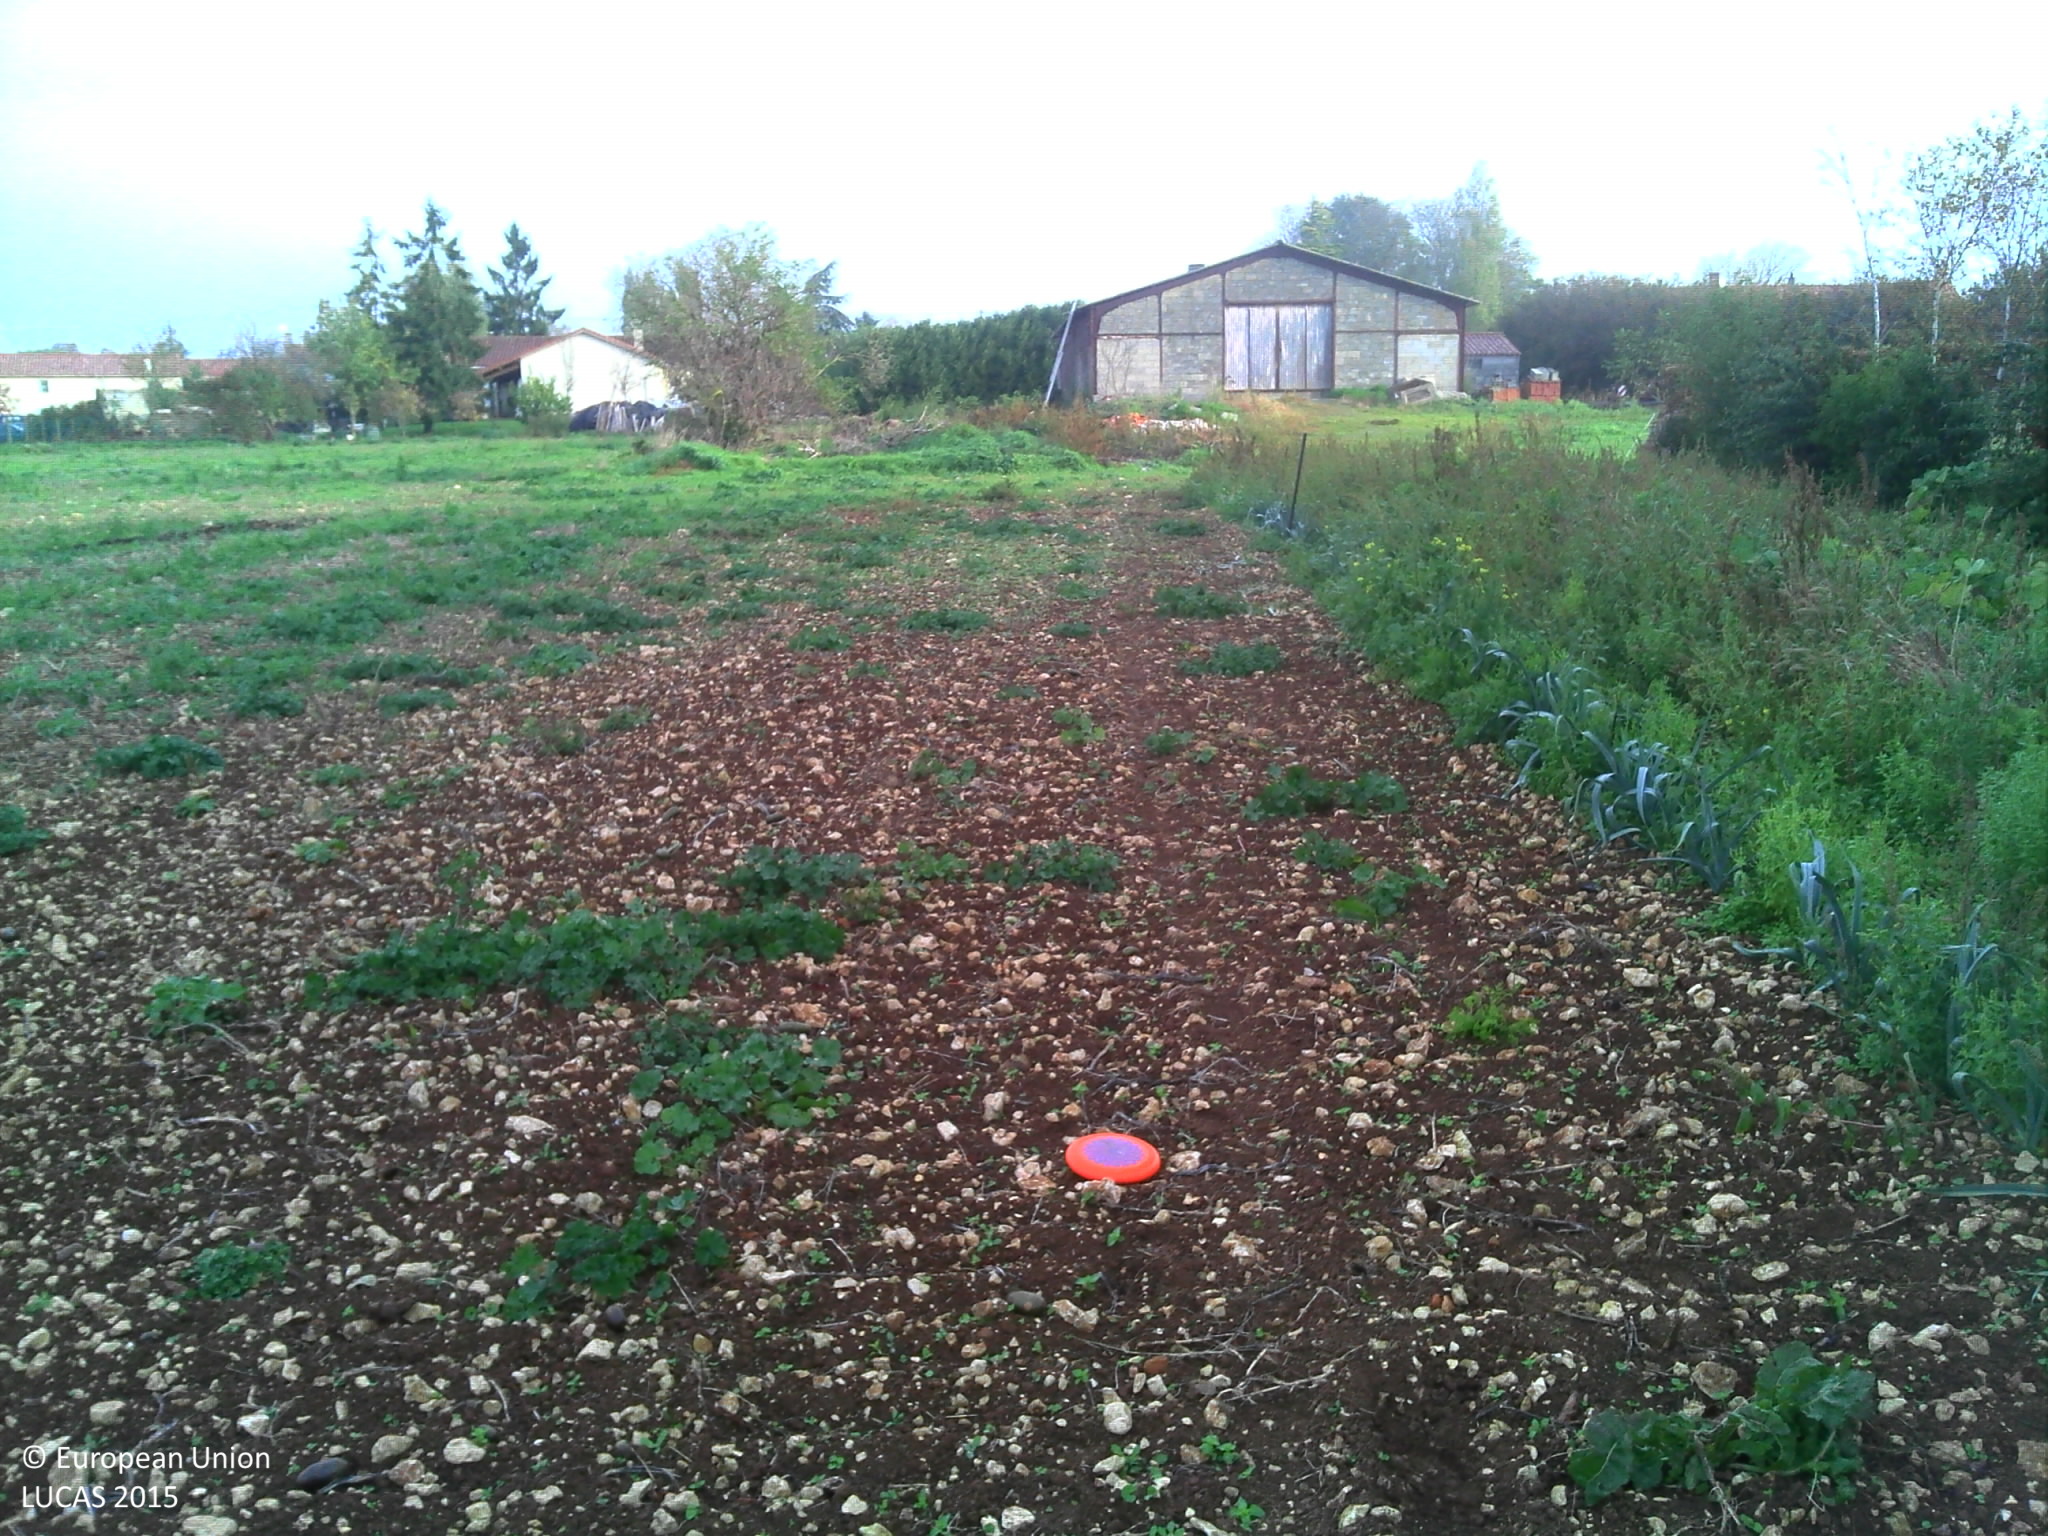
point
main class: Grassland
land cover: Spontaneously vegetated surfaces
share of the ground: 25 - 50 %
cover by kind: unconsolidated bare surface 85 %, herbaceous plants 15 %
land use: Fallow land
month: October
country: FR
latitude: 46.4688
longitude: -1.0364
